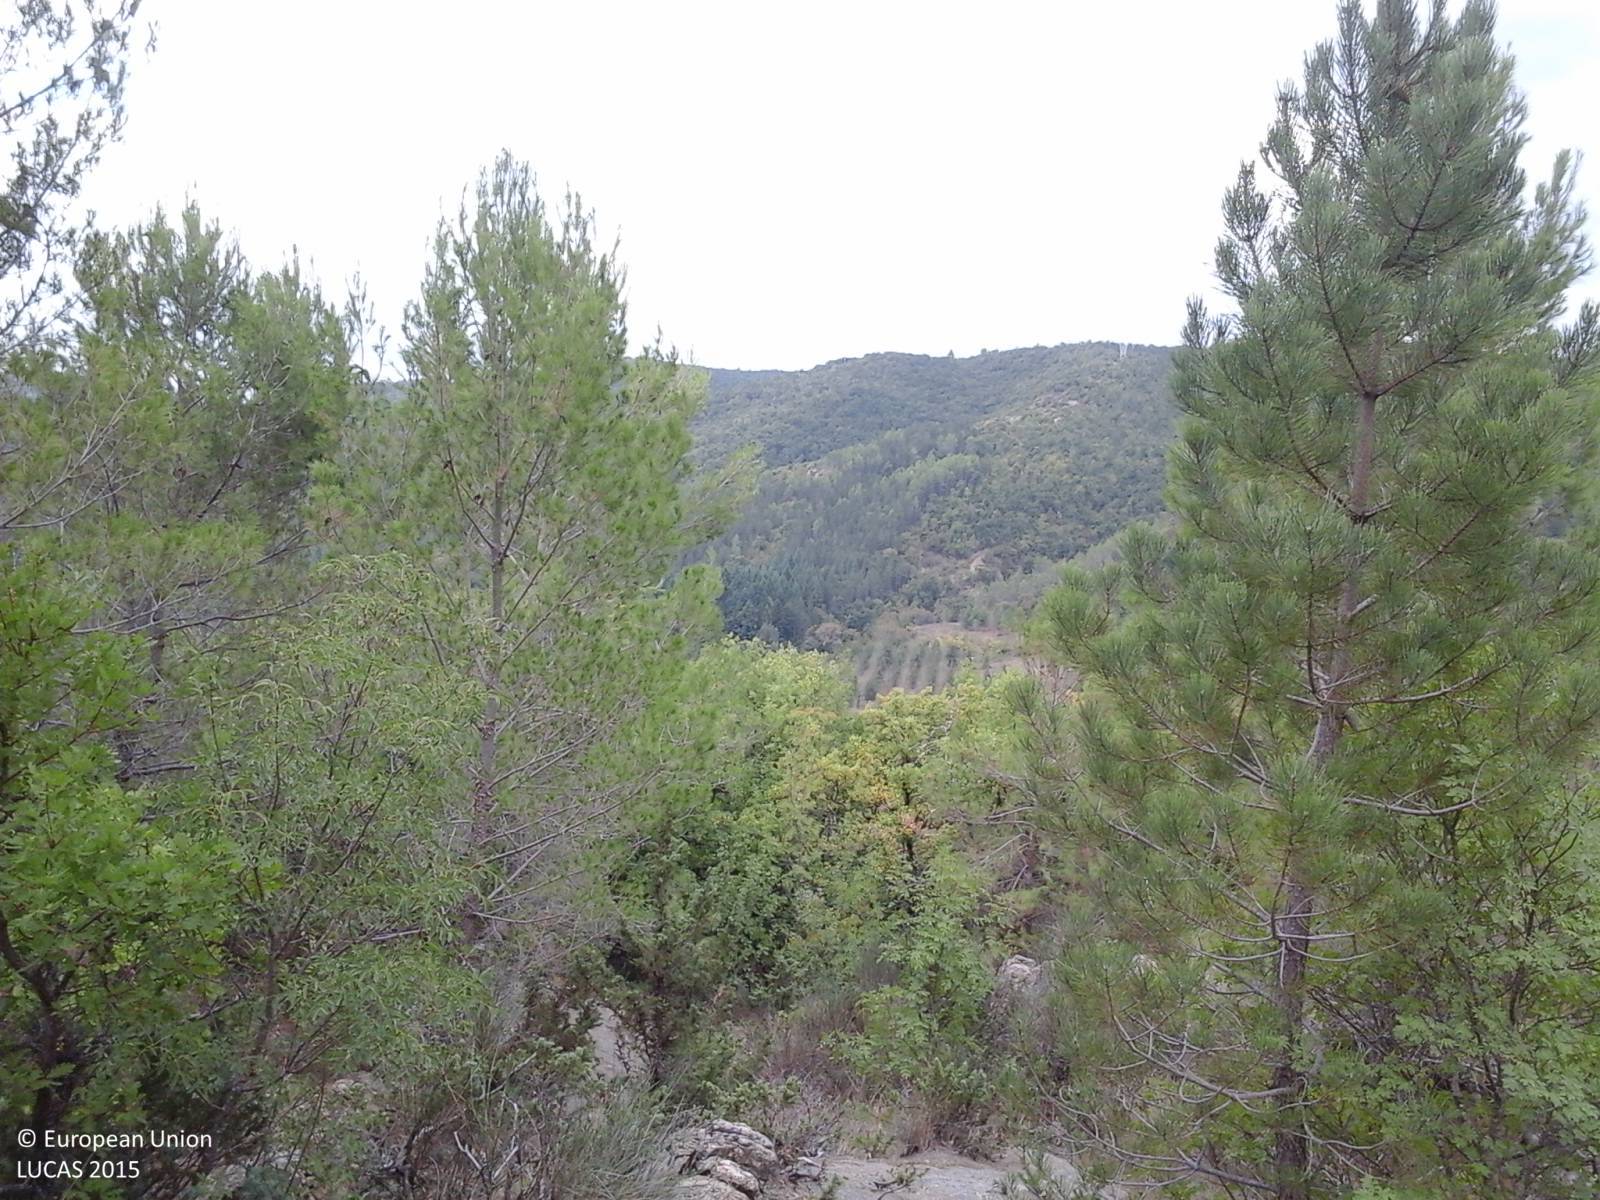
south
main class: Woodland
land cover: Broadleaved woodland
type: thermophilous deciduous forest
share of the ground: > 75 %
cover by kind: broadleaved forest trees 100 %
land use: Forestry
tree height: > 5 m
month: September
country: IT
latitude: 42.9179
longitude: 12.2594
